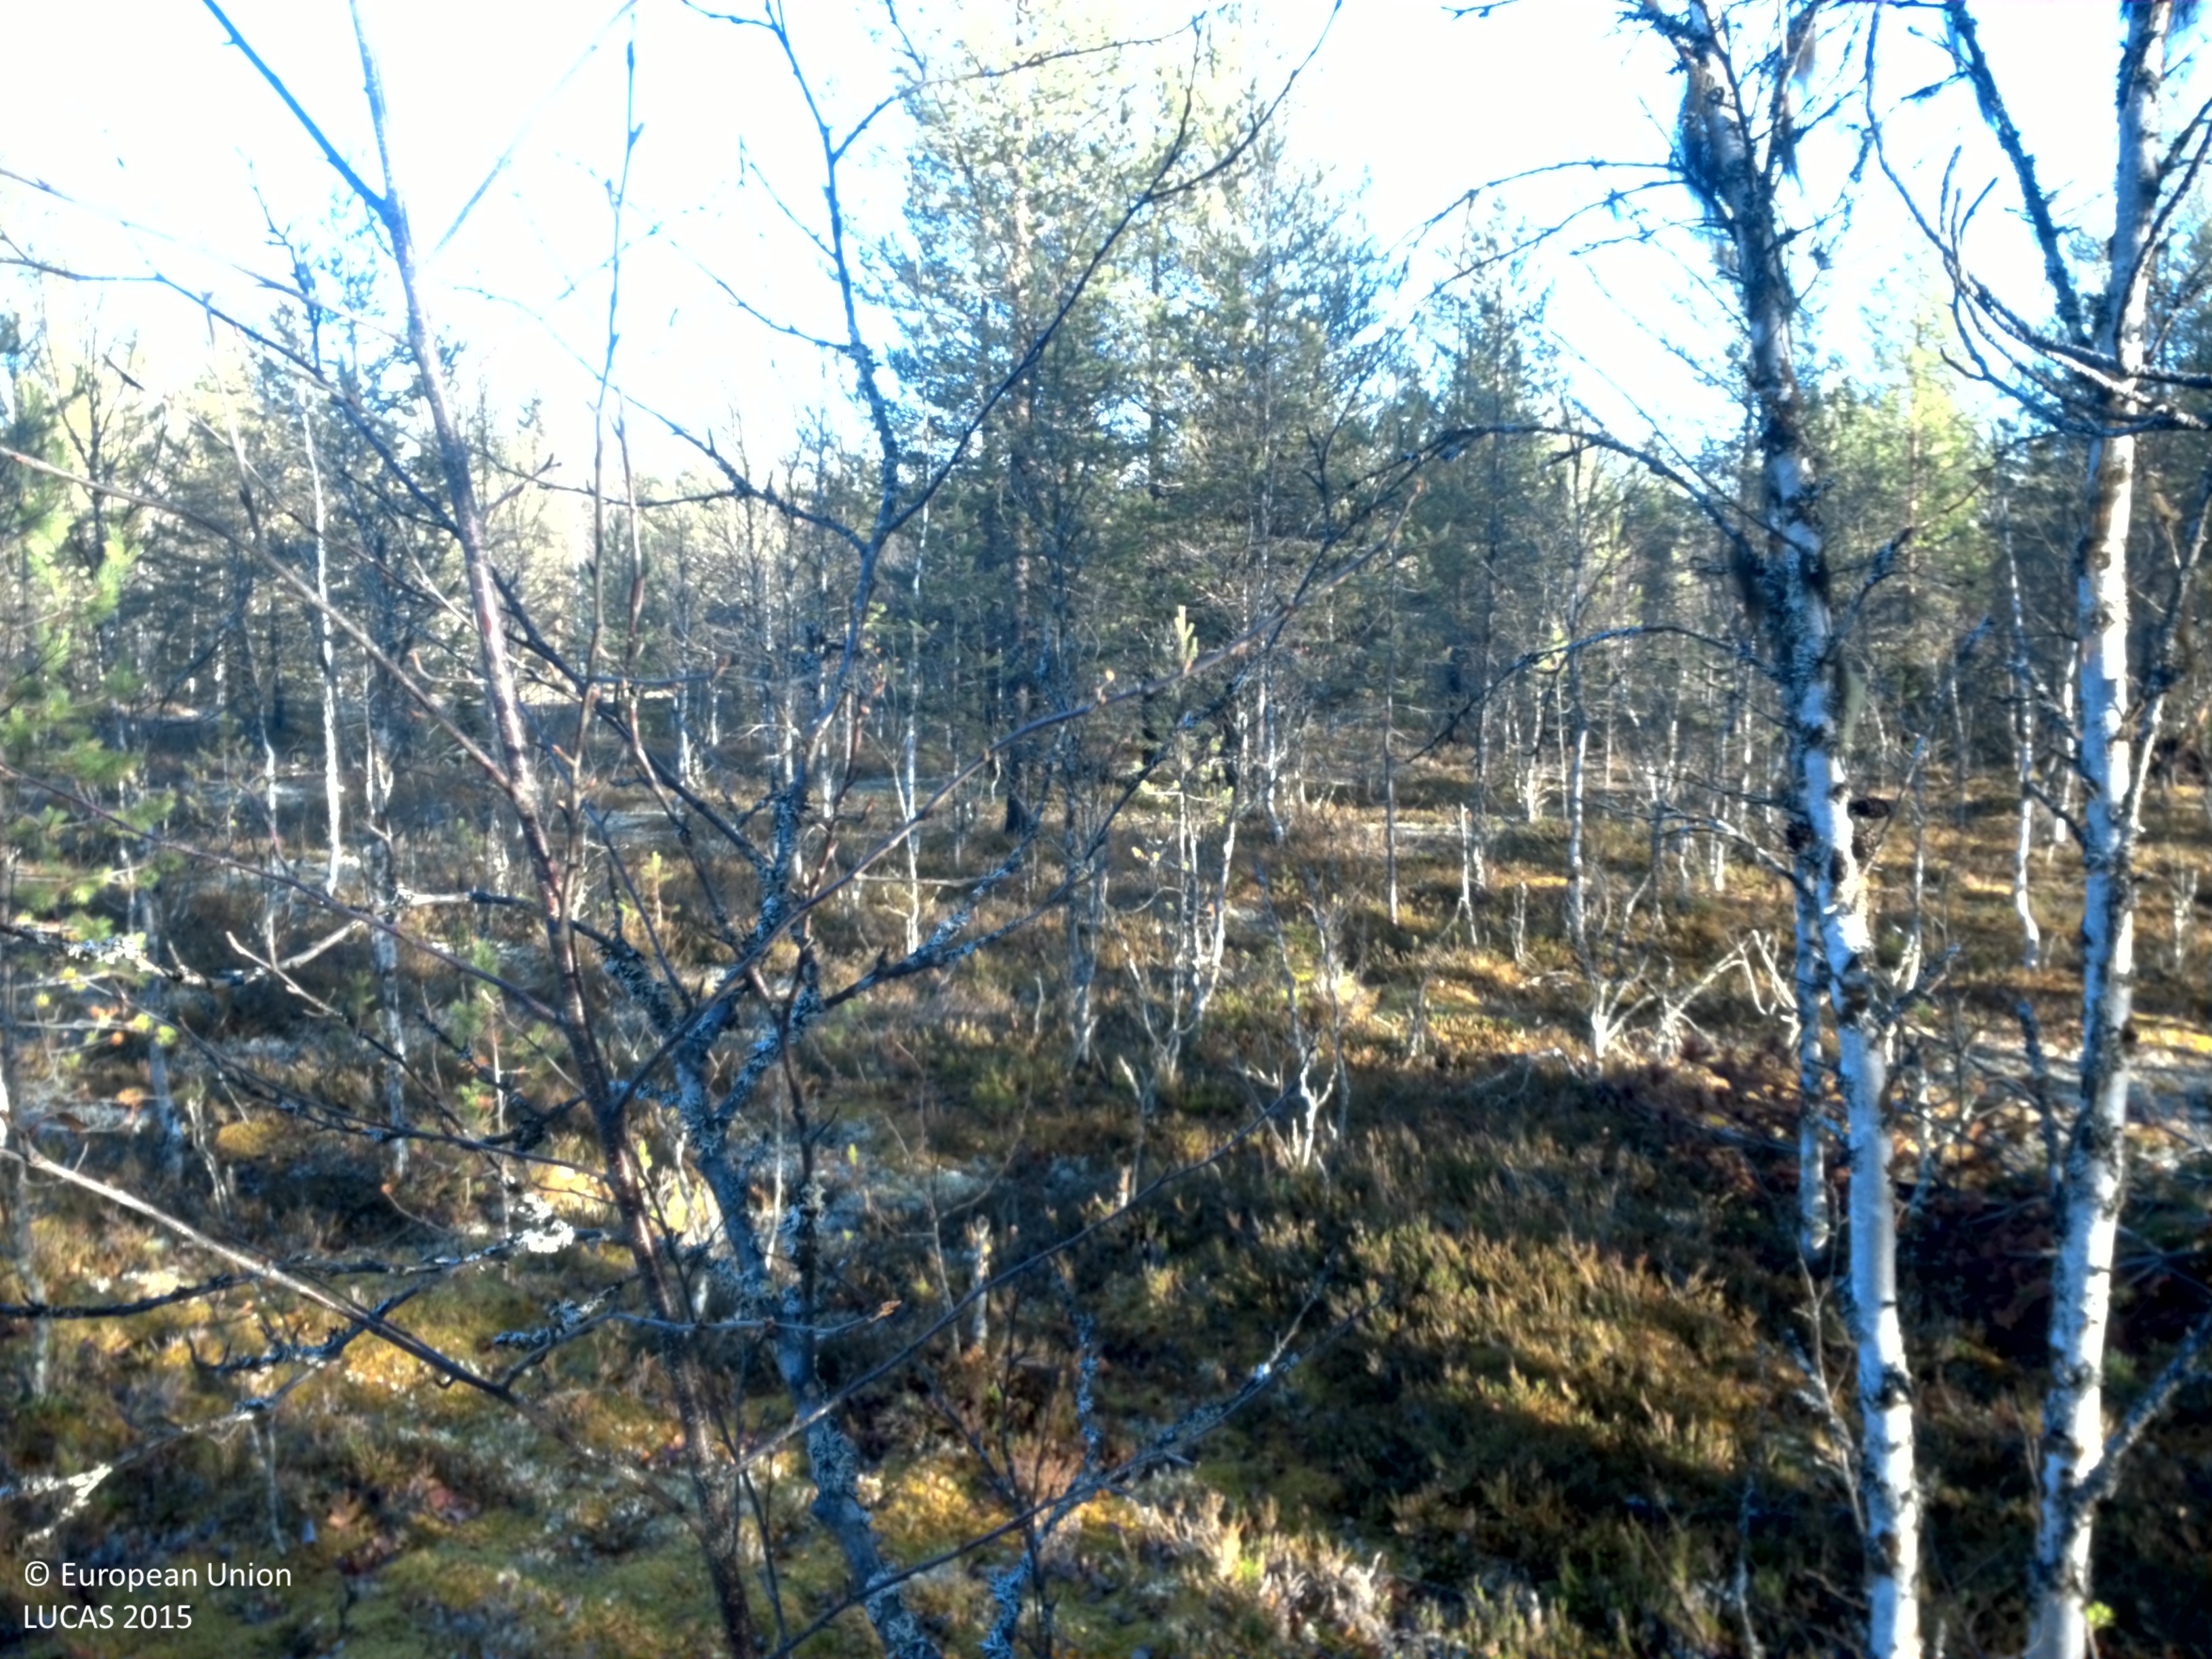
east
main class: Woodland
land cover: Pine dominated mixed woodland
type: boreal forest
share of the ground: 25 - 50 %
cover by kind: shrubs 40 %, lichens and mosses 30 %, coniferous forest trees 20 %, broadleaved forest trees 10 %
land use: Forestry
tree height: > 5 m
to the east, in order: Pine dominated mixed woodland; Tracks; Pine dominated mixed woodland; Ditches and canals; Paved roads, cycling and walking lanes; Ditches and canals; Pine dominated mixed woodland
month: October
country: SE
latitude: 64.4958
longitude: 17.4399
